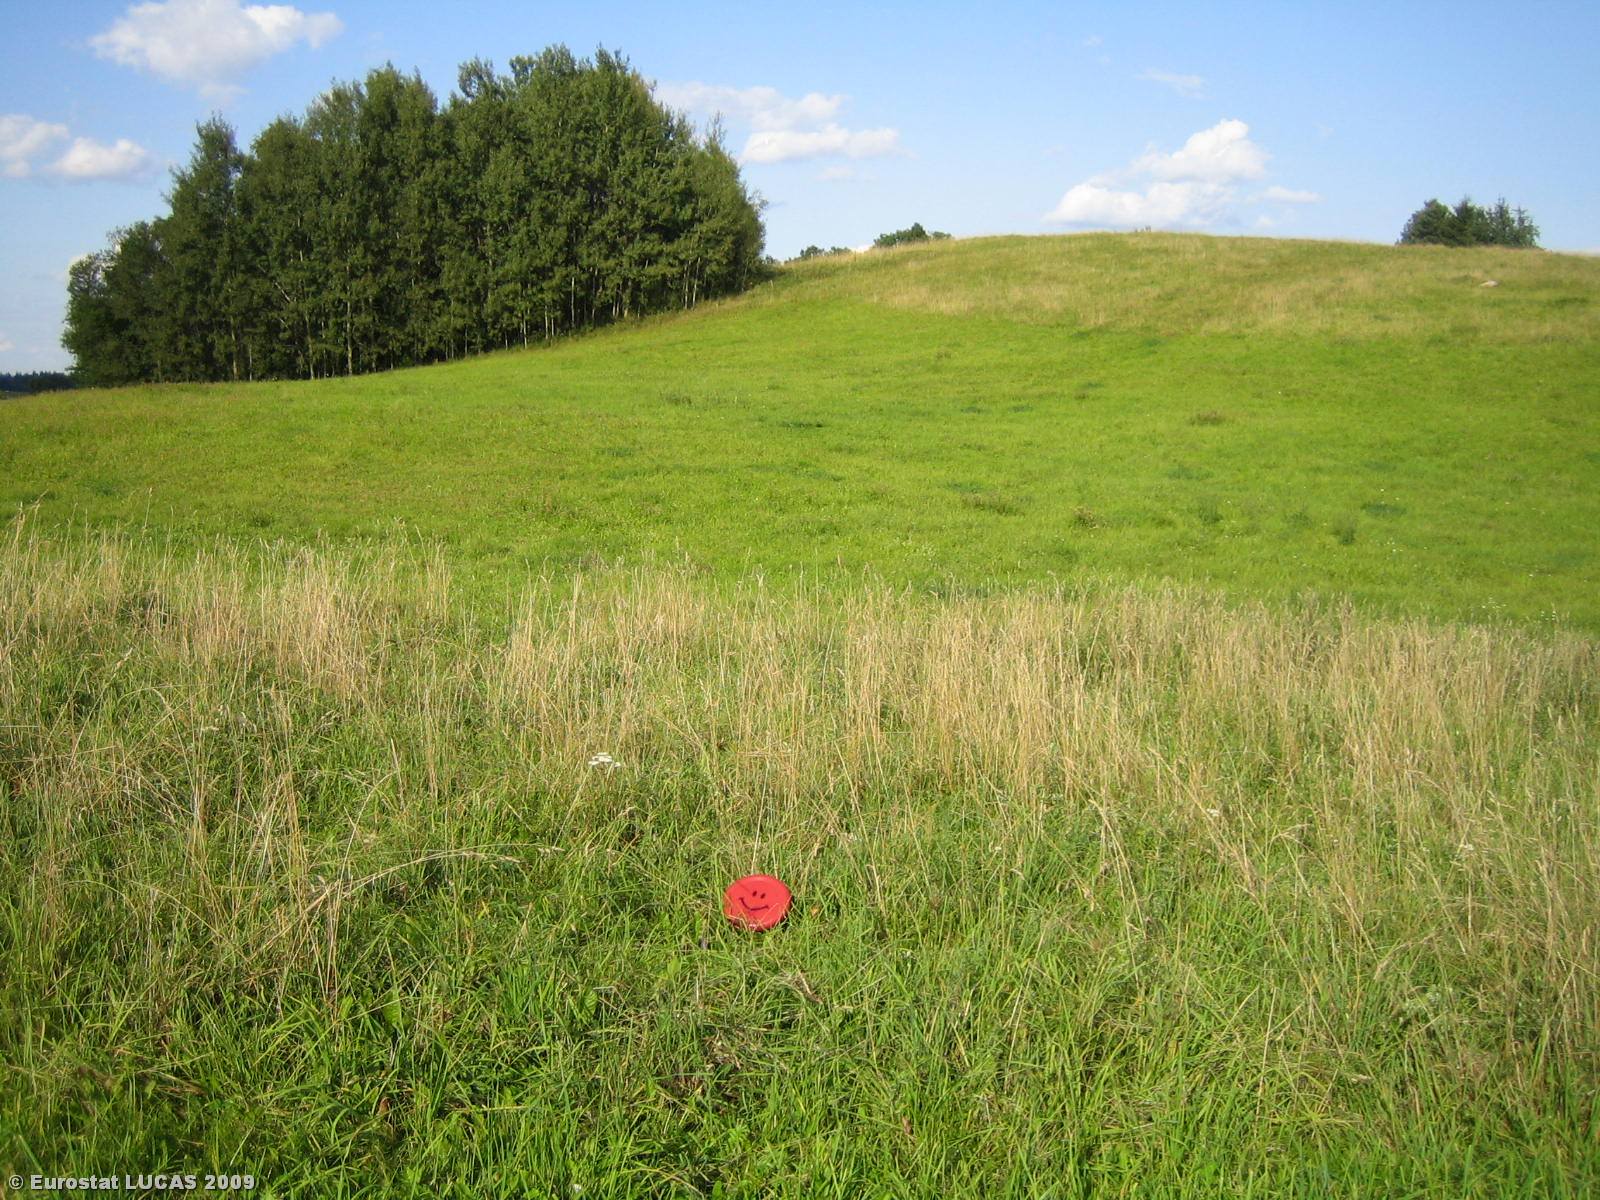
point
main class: Grassland
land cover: Grassland without tree/shrub cover
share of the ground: > 75 %
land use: Agriculture (excluding fallow land and kitchen gardens)
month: August
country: LT
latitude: 54.7146
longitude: 24.5238
